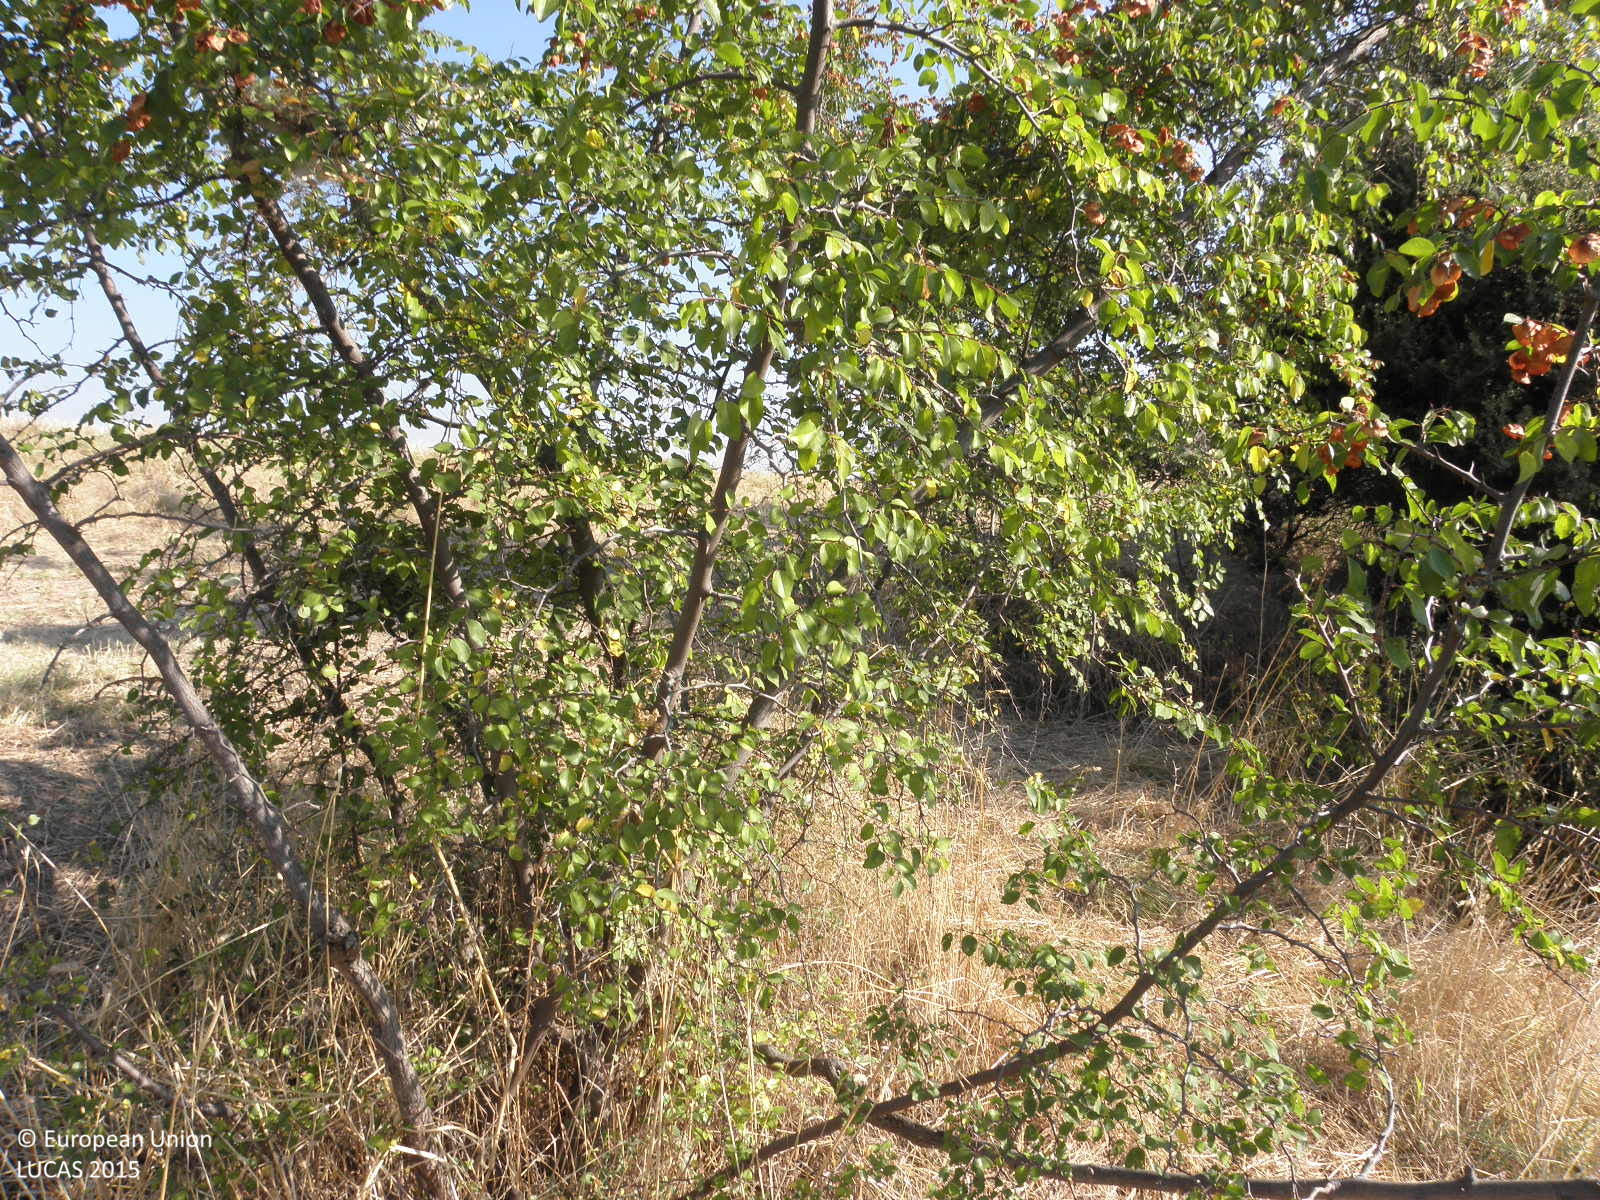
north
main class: Woodland
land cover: Broadleaved woodland
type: thermophilous deciduous forest
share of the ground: 50 - 75 %
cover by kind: broadleaved forest trees 60 %, shrubs 30 %, herbaceous plants 10 %
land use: Semi-natural and natural areas not in use
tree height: > 5 m
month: September
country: GR
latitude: 40.2394
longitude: 22.4451
